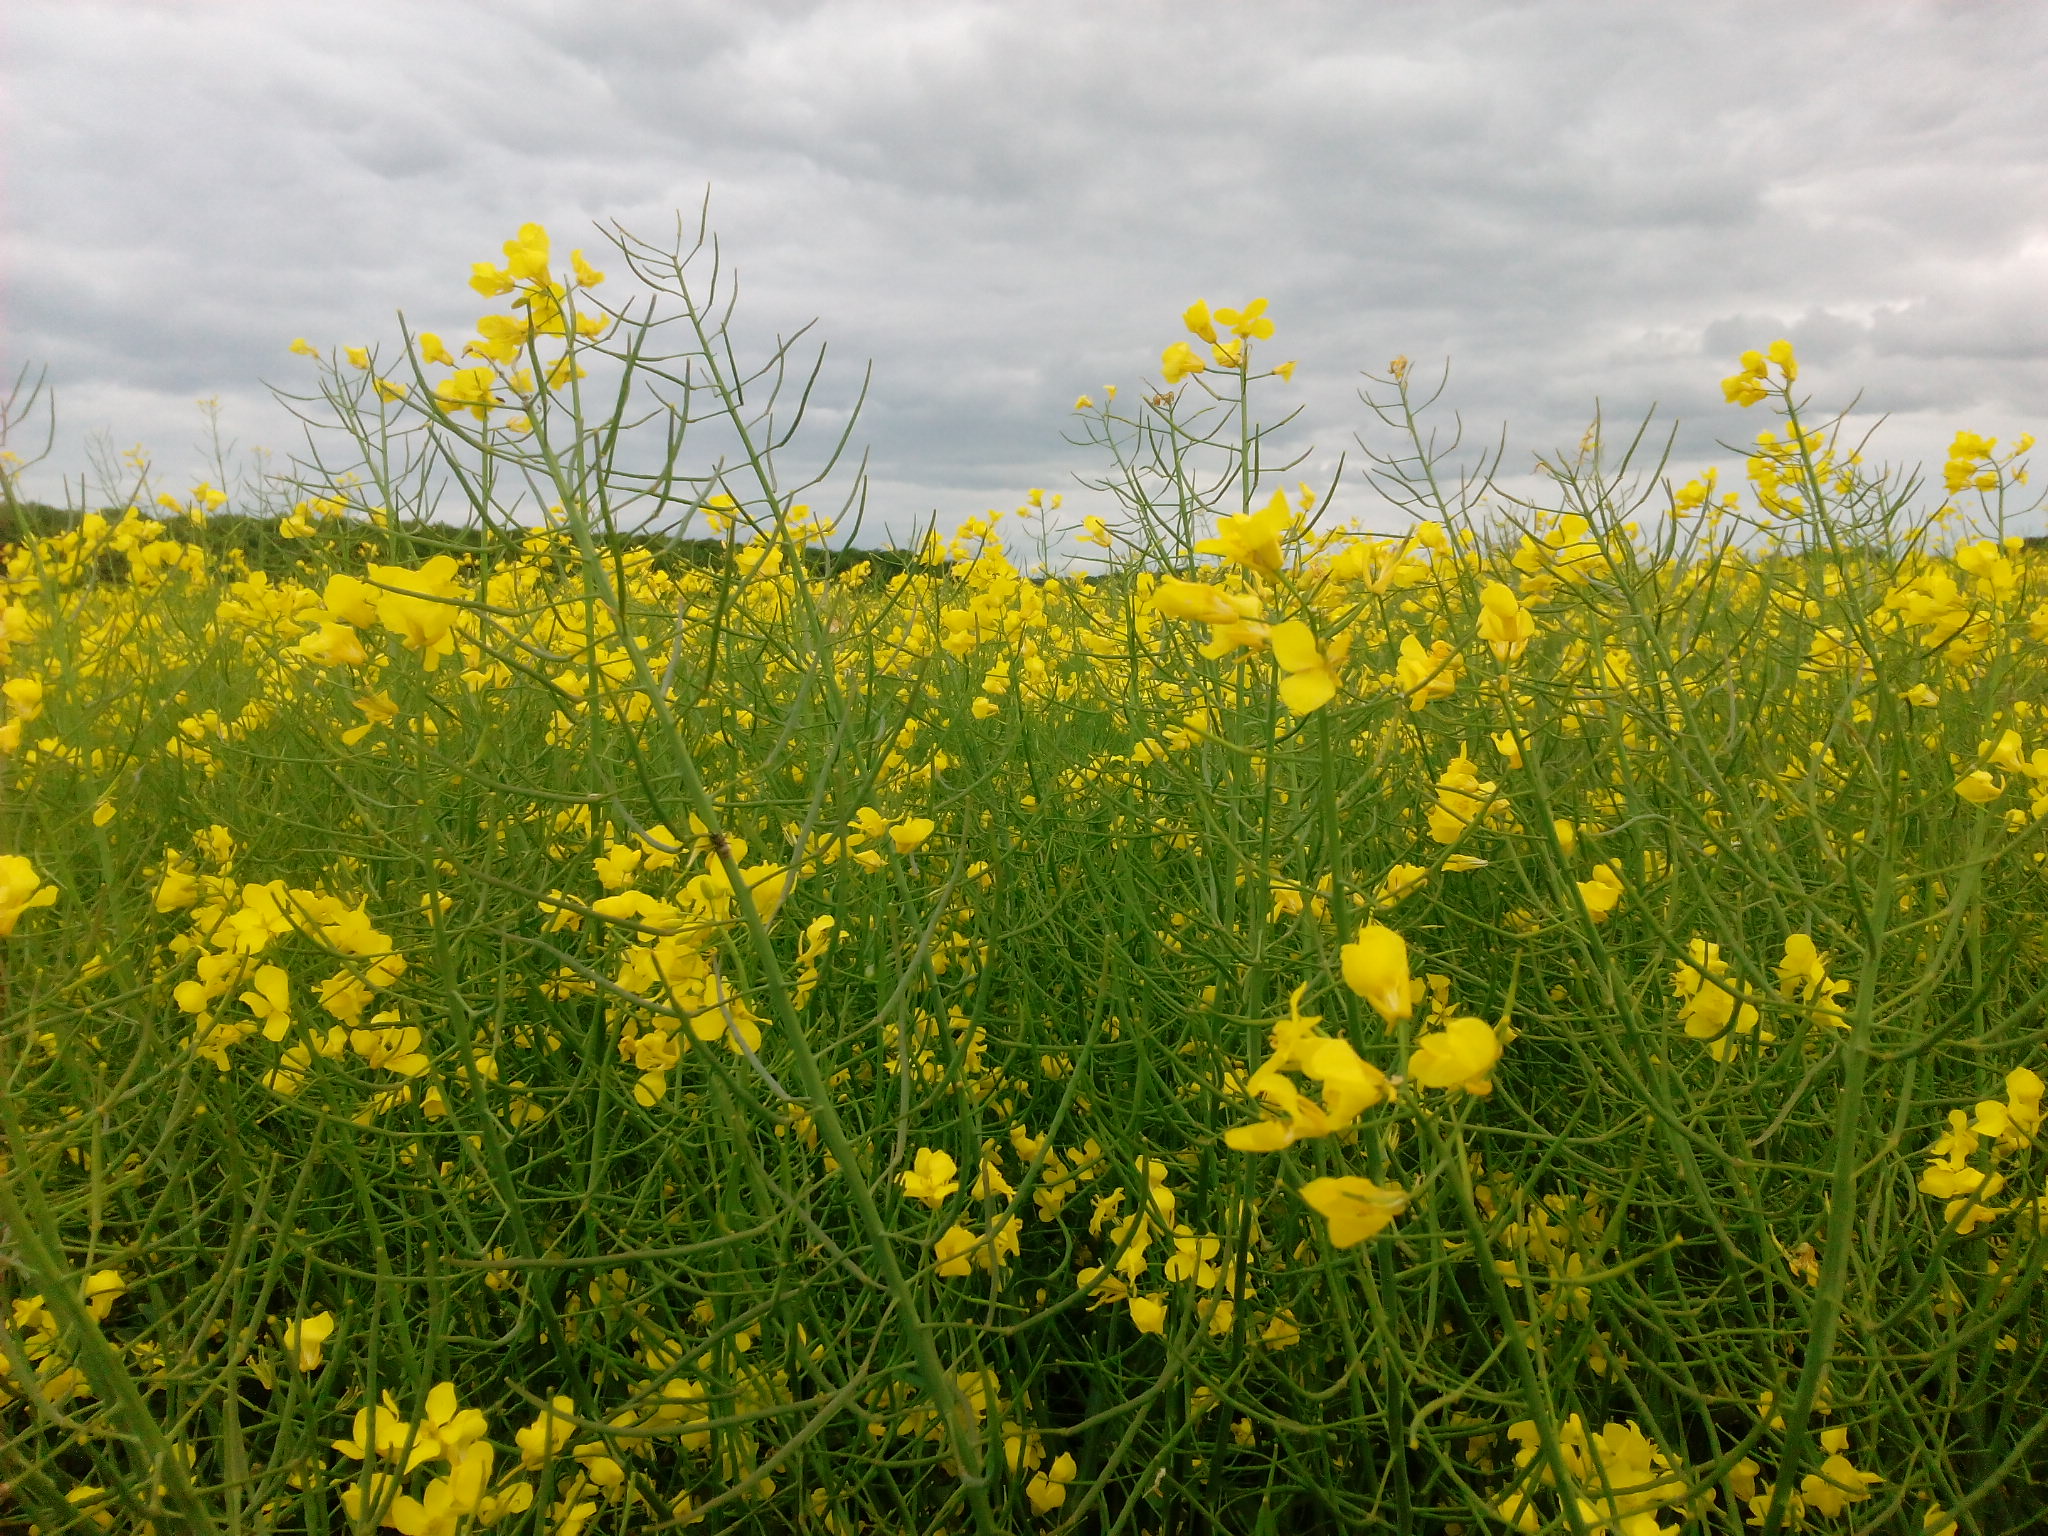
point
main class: Cropland
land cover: Rape and turnip rape
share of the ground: > 75 %
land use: Agriculture (excluding fallow land and kitchen gardens)
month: May
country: DE
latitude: 53.7546
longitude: 13.2300
